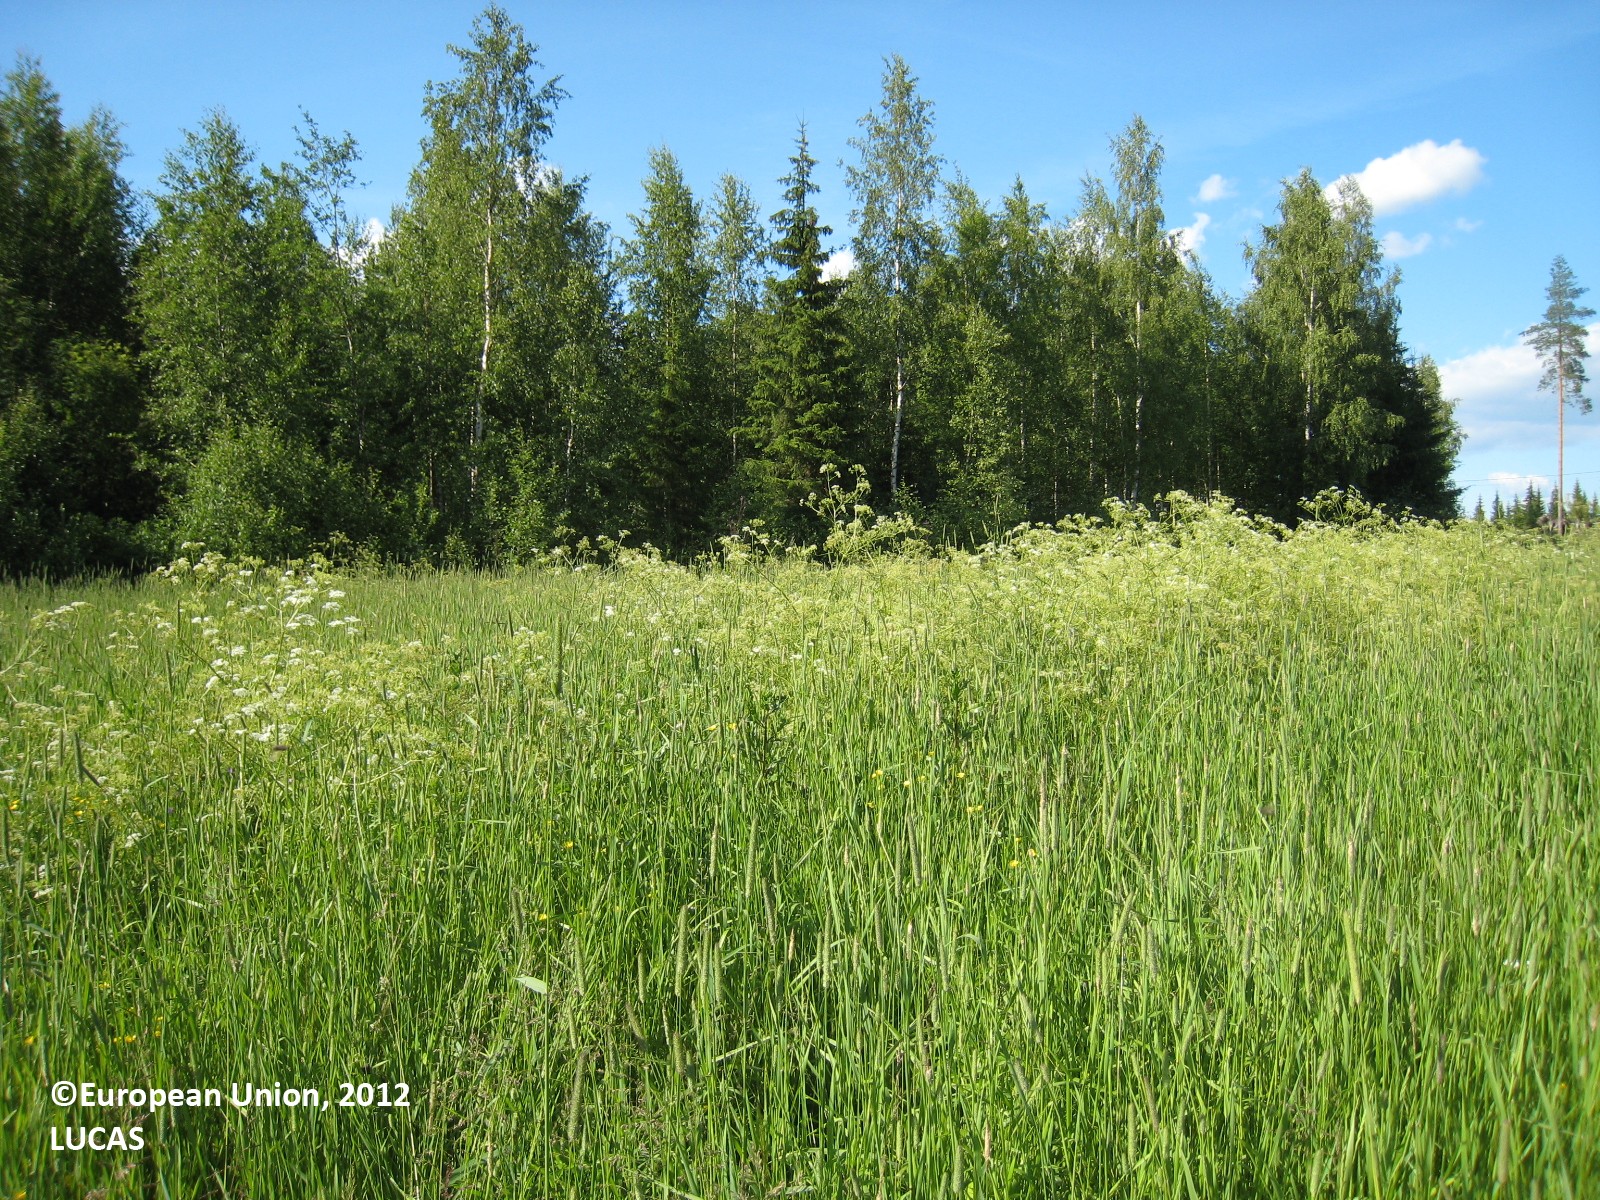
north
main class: Cropland
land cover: Temporary grasslands
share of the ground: > 75 %
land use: Agriculture (excluding fallow land and kitchen gardens)
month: July
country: FI
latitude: 62.6385
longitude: 26.1383
